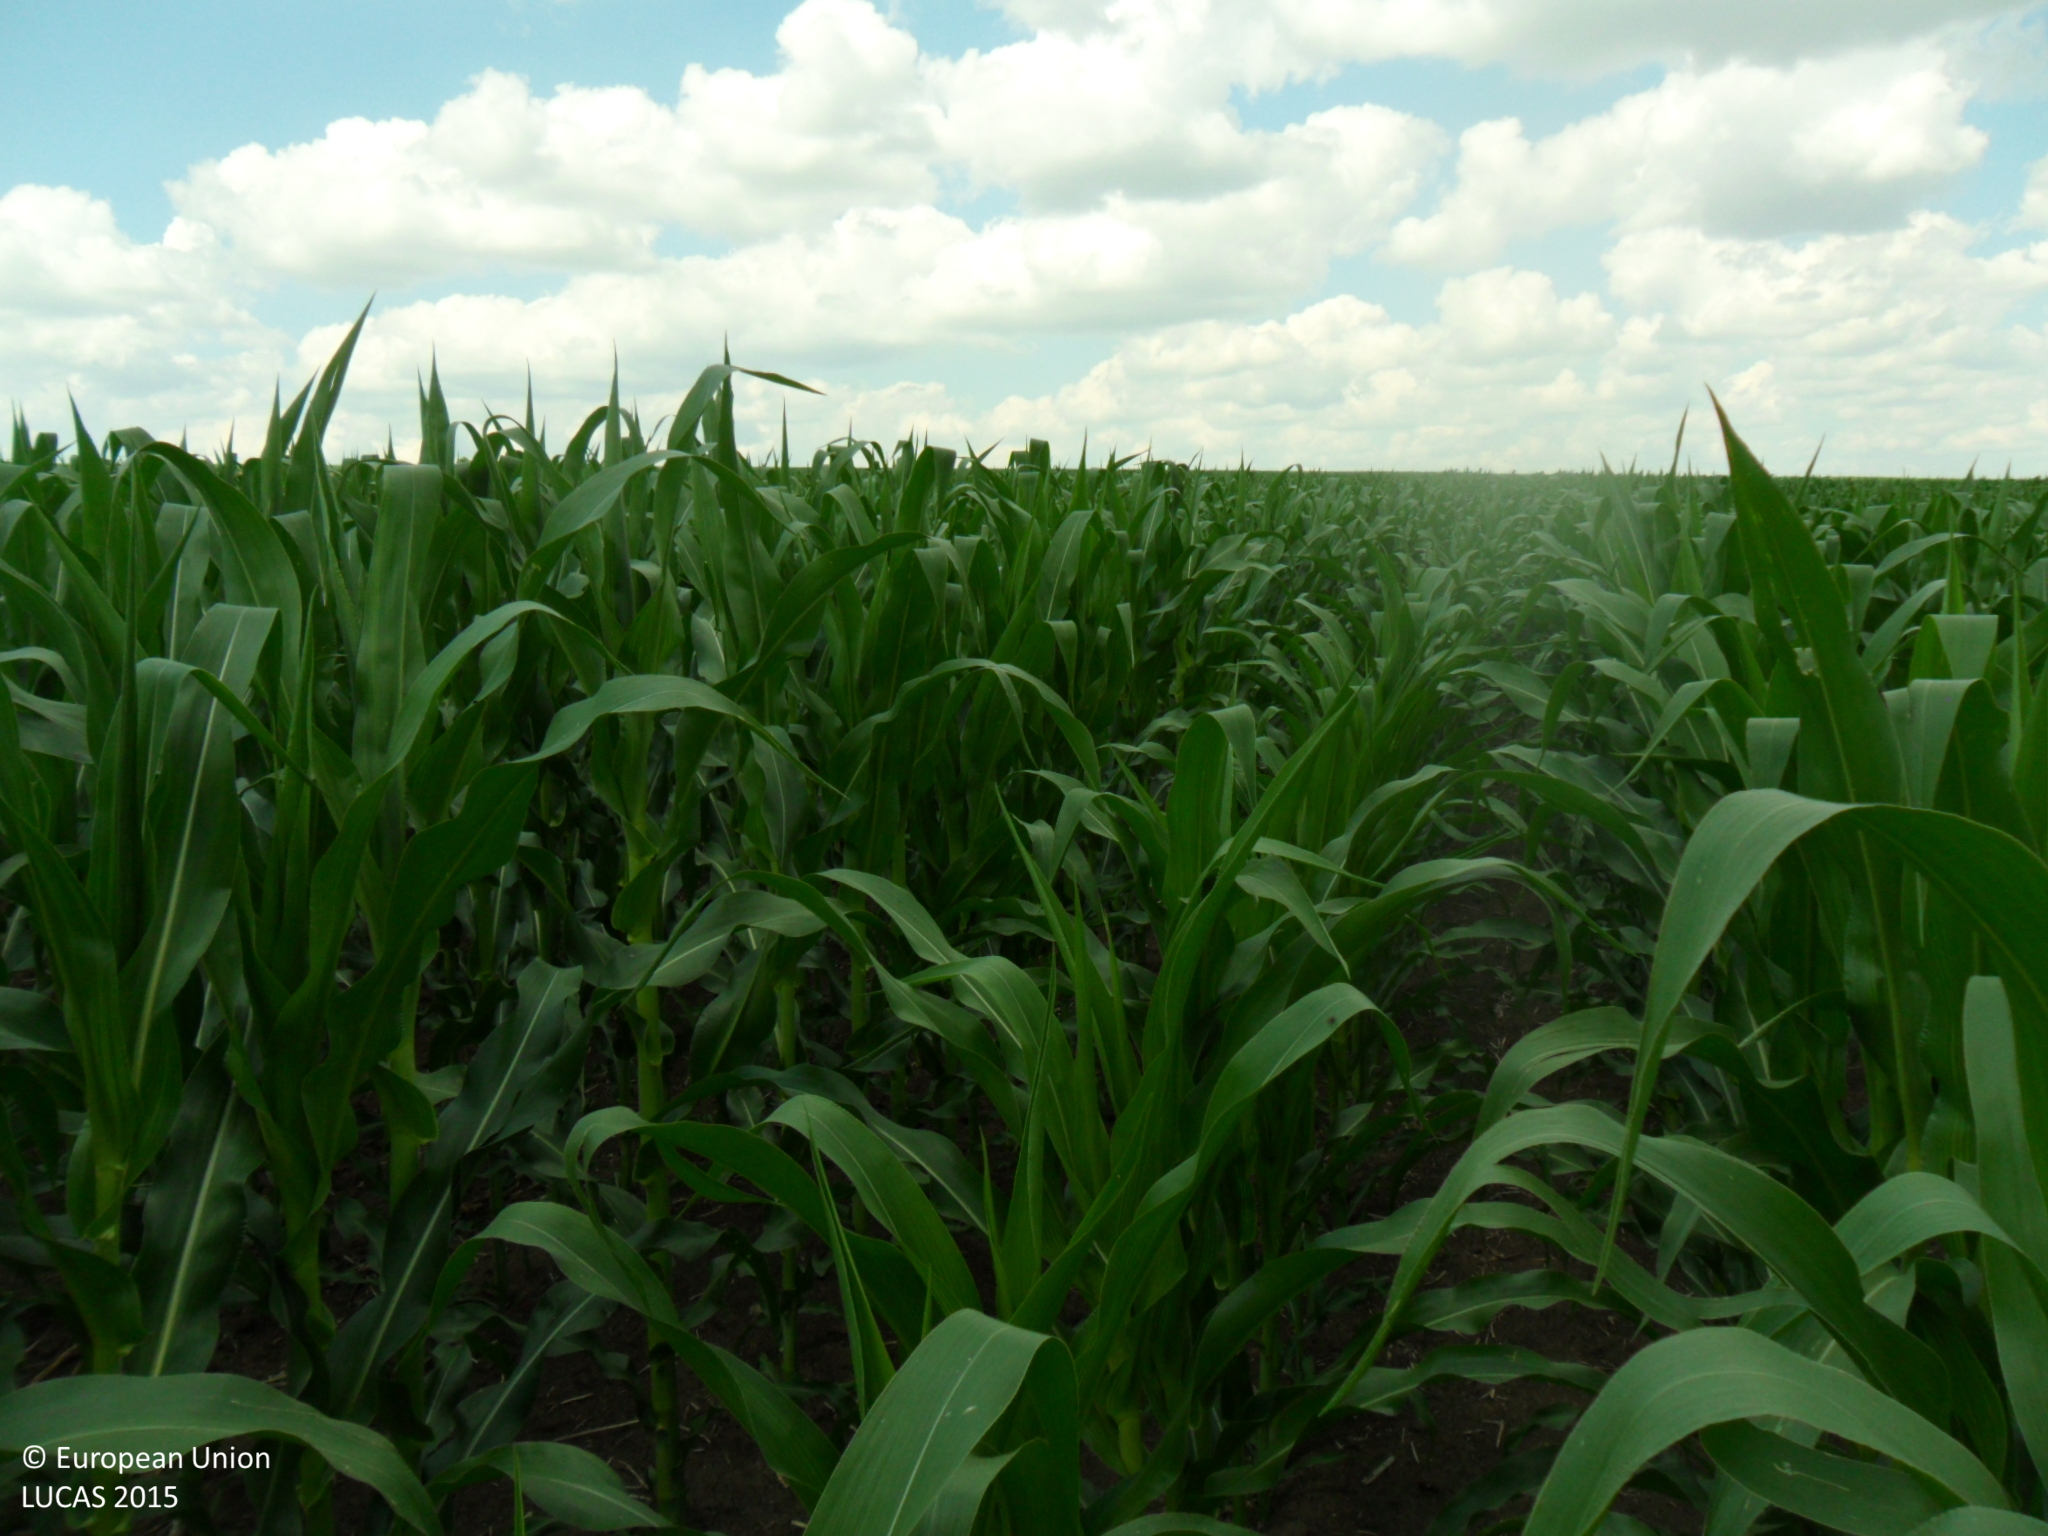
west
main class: Cropland
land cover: Maize
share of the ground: > 75 %
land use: Agriculture (excluding fallow land and kitchen gardens)
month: June
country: BG
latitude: 43.3491
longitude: 27.0555
